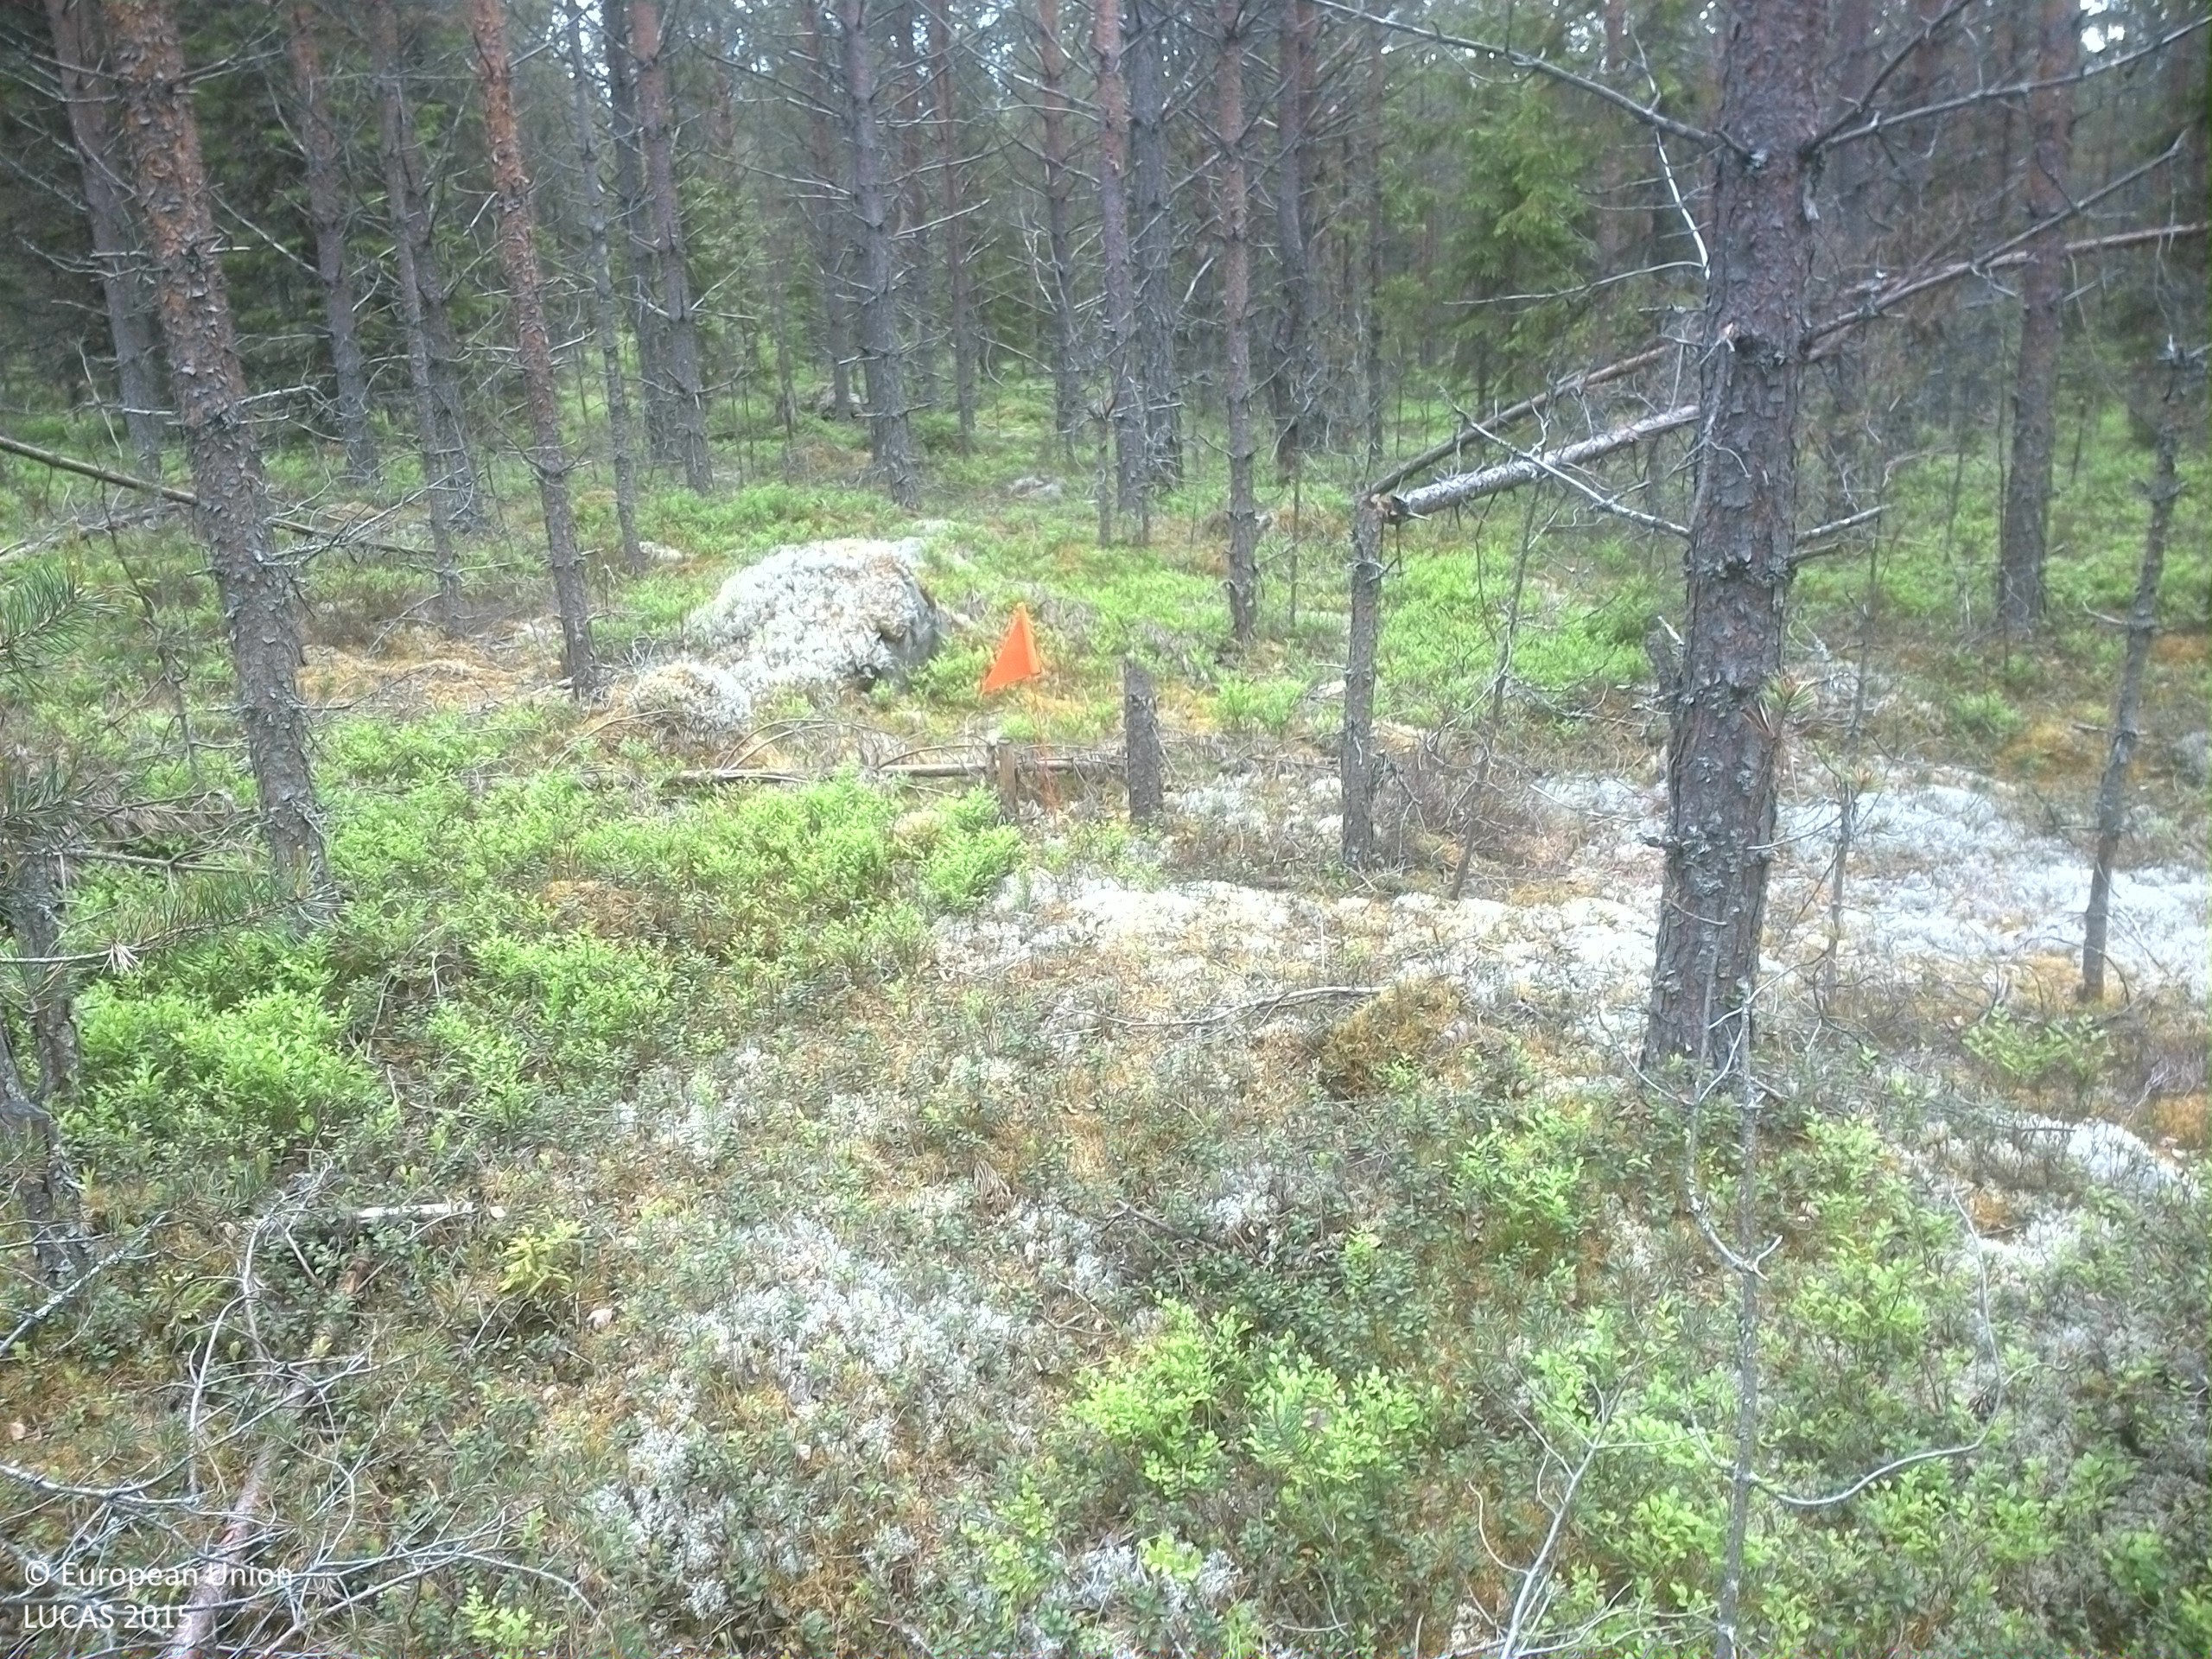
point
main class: Woodland
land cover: Pine dominated coniferous woodland
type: boreal forest
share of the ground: 50 - 75 %
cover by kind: coniferous forest trees 70 %, shrubs 30 %
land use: Forestry
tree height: > 5 m
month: June
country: SE
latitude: 63.4929
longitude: 17.9073
